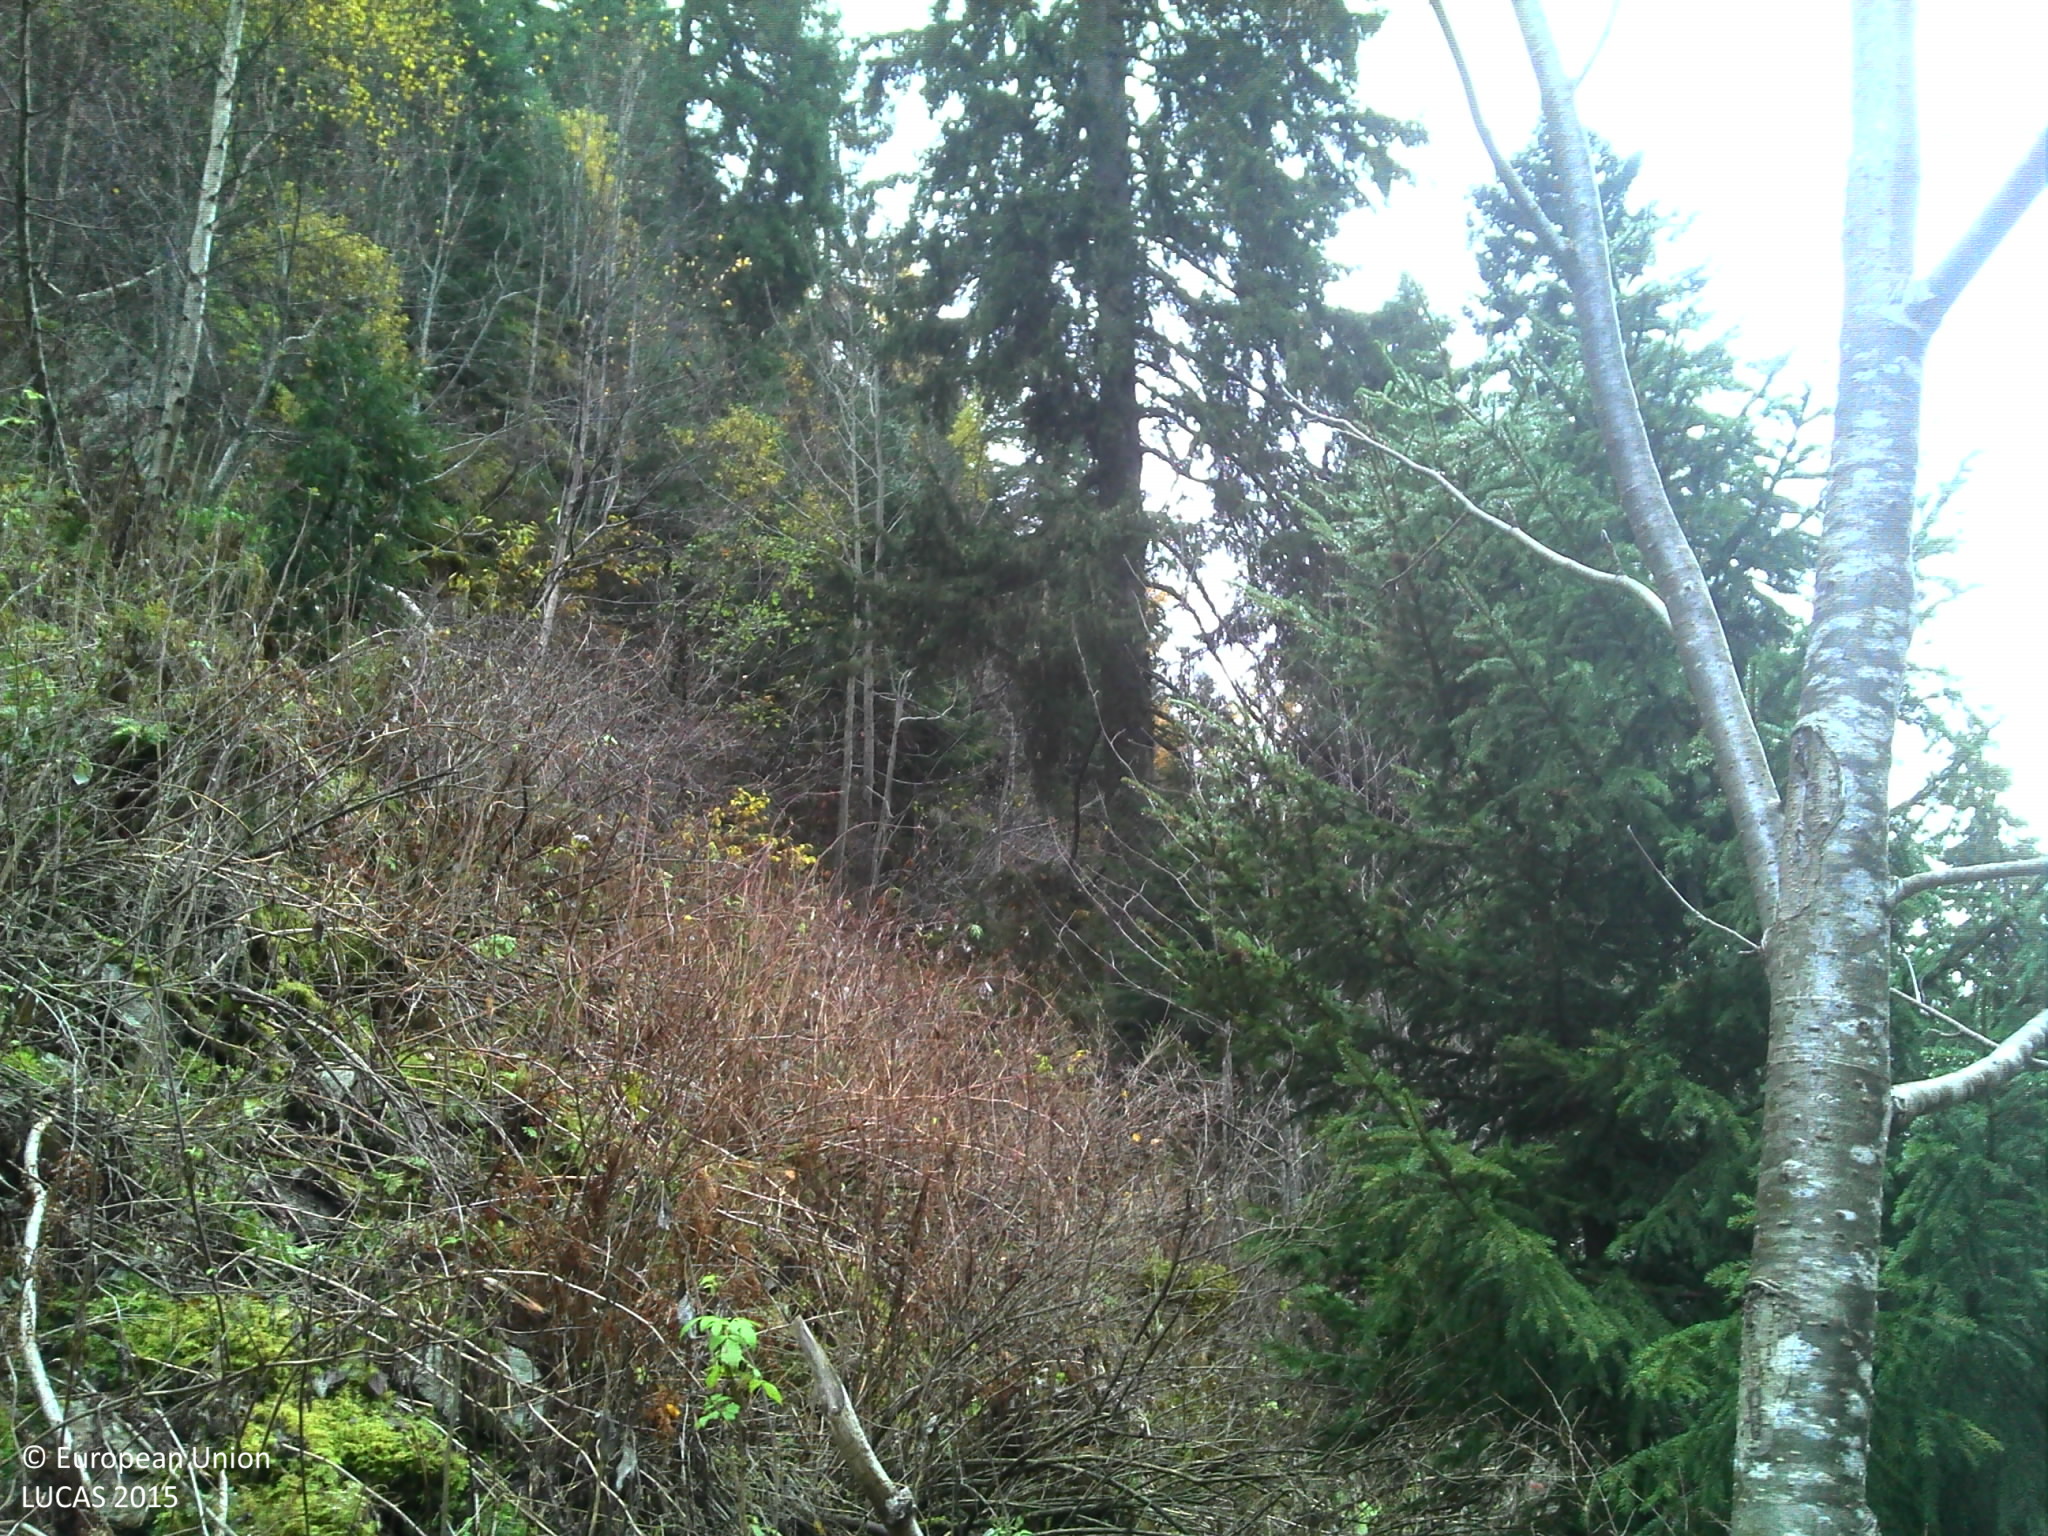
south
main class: Woodland
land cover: Spruce dominated mixed woodland
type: alpine coniferous forest
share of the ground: > 75 %
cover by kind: coniferous forest trees 55 %, broadleaved forest trees 35 %, consolidated bare surface 10 %
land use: Forestry
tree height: > 5 m
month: October
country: FR
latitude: 45.5729
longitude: 6.5062
